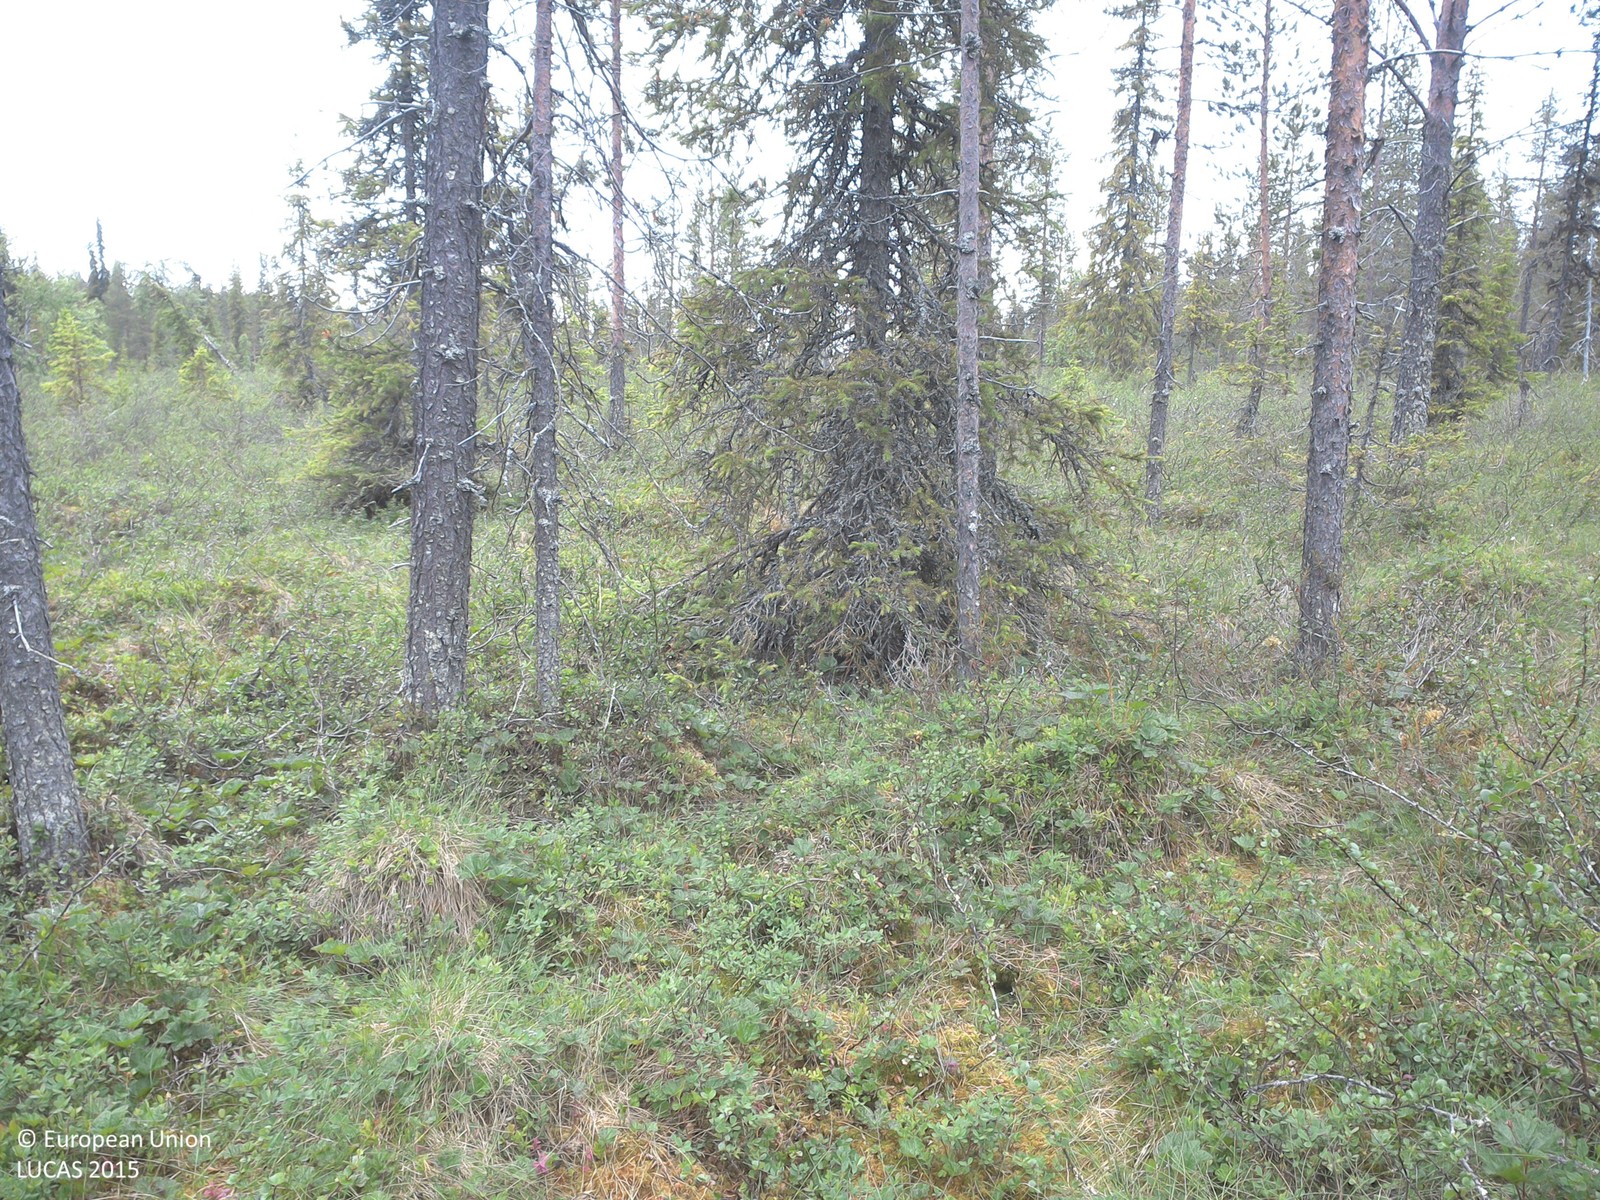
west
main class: Woodland
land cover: Pine dominated coniferous woodland
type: boreal forest
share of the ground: 10 - 25 %
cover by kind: shrubs 40 %, lichens and mosses 30 %, coniferous forest trees 15 %, herbaceous plants 15 %
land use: Semi-natural and natural areas not in use
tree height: > 5 m
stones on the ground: < 10 %
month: July
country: SE
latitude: 67.6180
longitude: 22.9274
